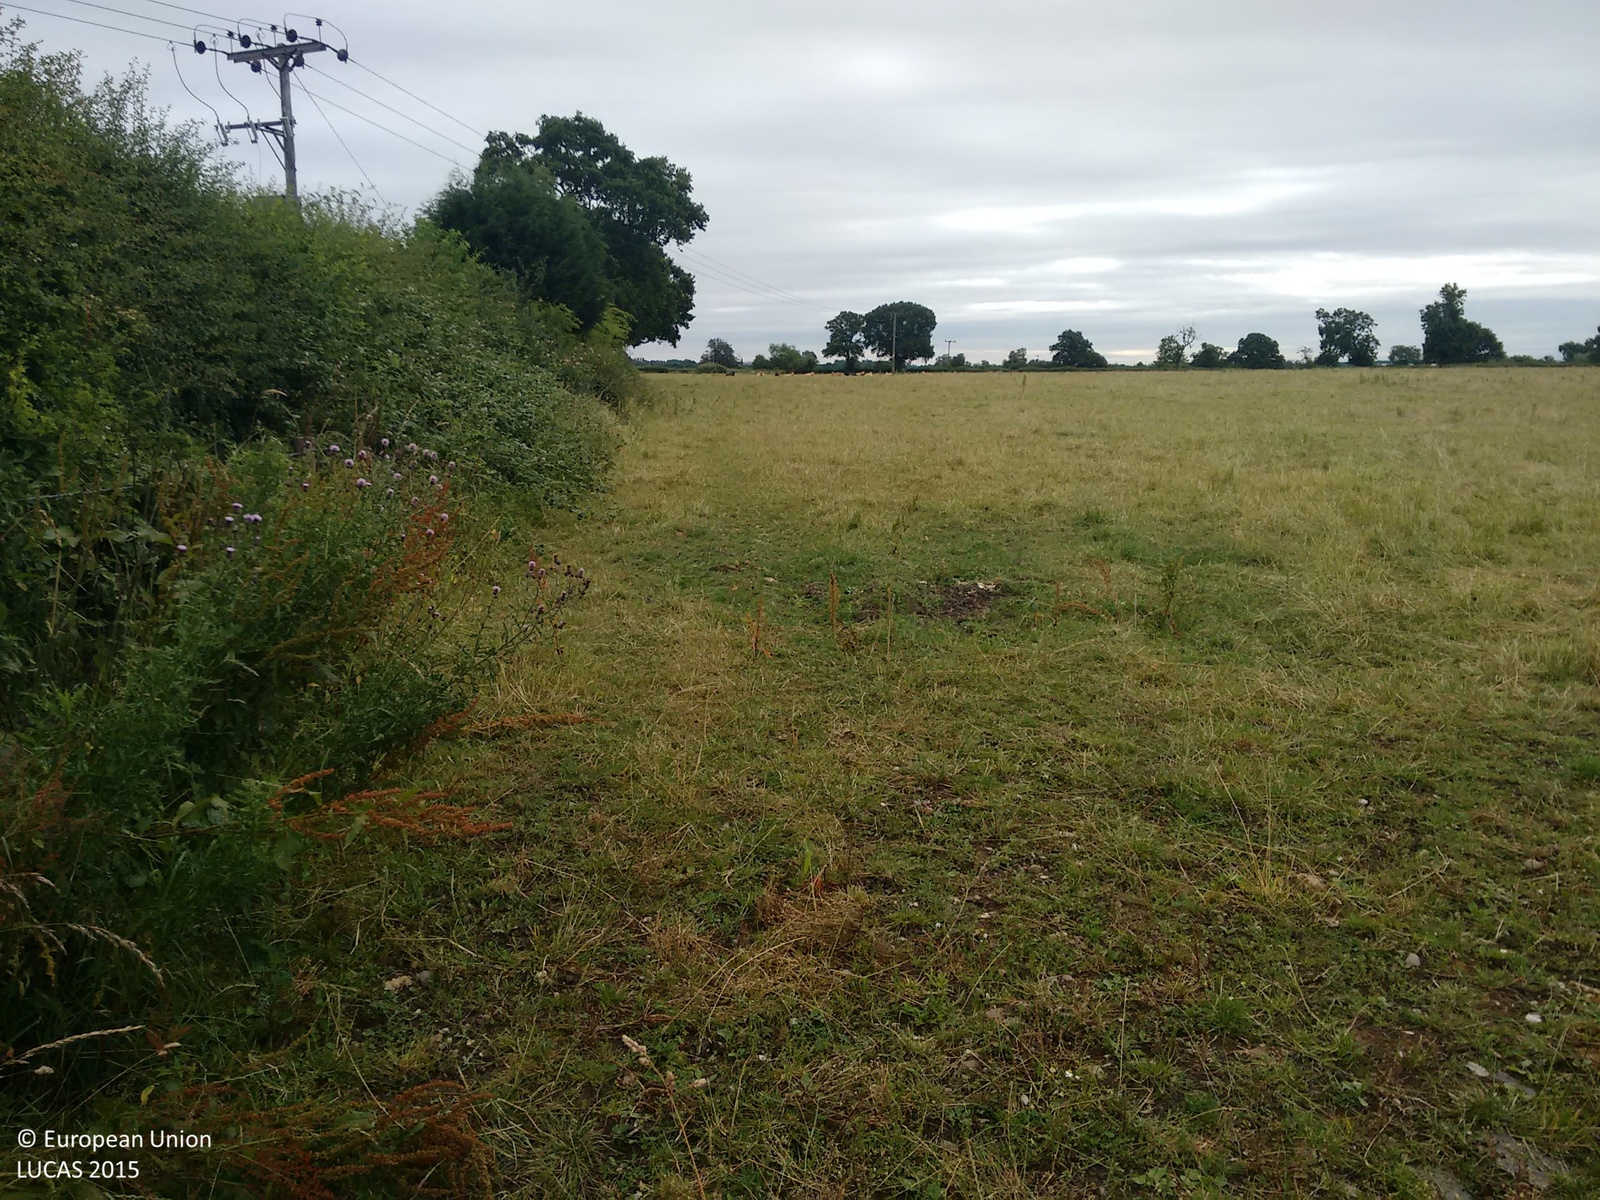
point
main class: Grassland
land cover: Grassland without tree/shrub cover
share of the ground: > 75 %
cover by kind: herbaceous plants 100 %
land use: Agriculture (excluding fallow land and kitchen gardens)
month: July
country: GB
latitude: 52.8817
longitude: -1.5681
